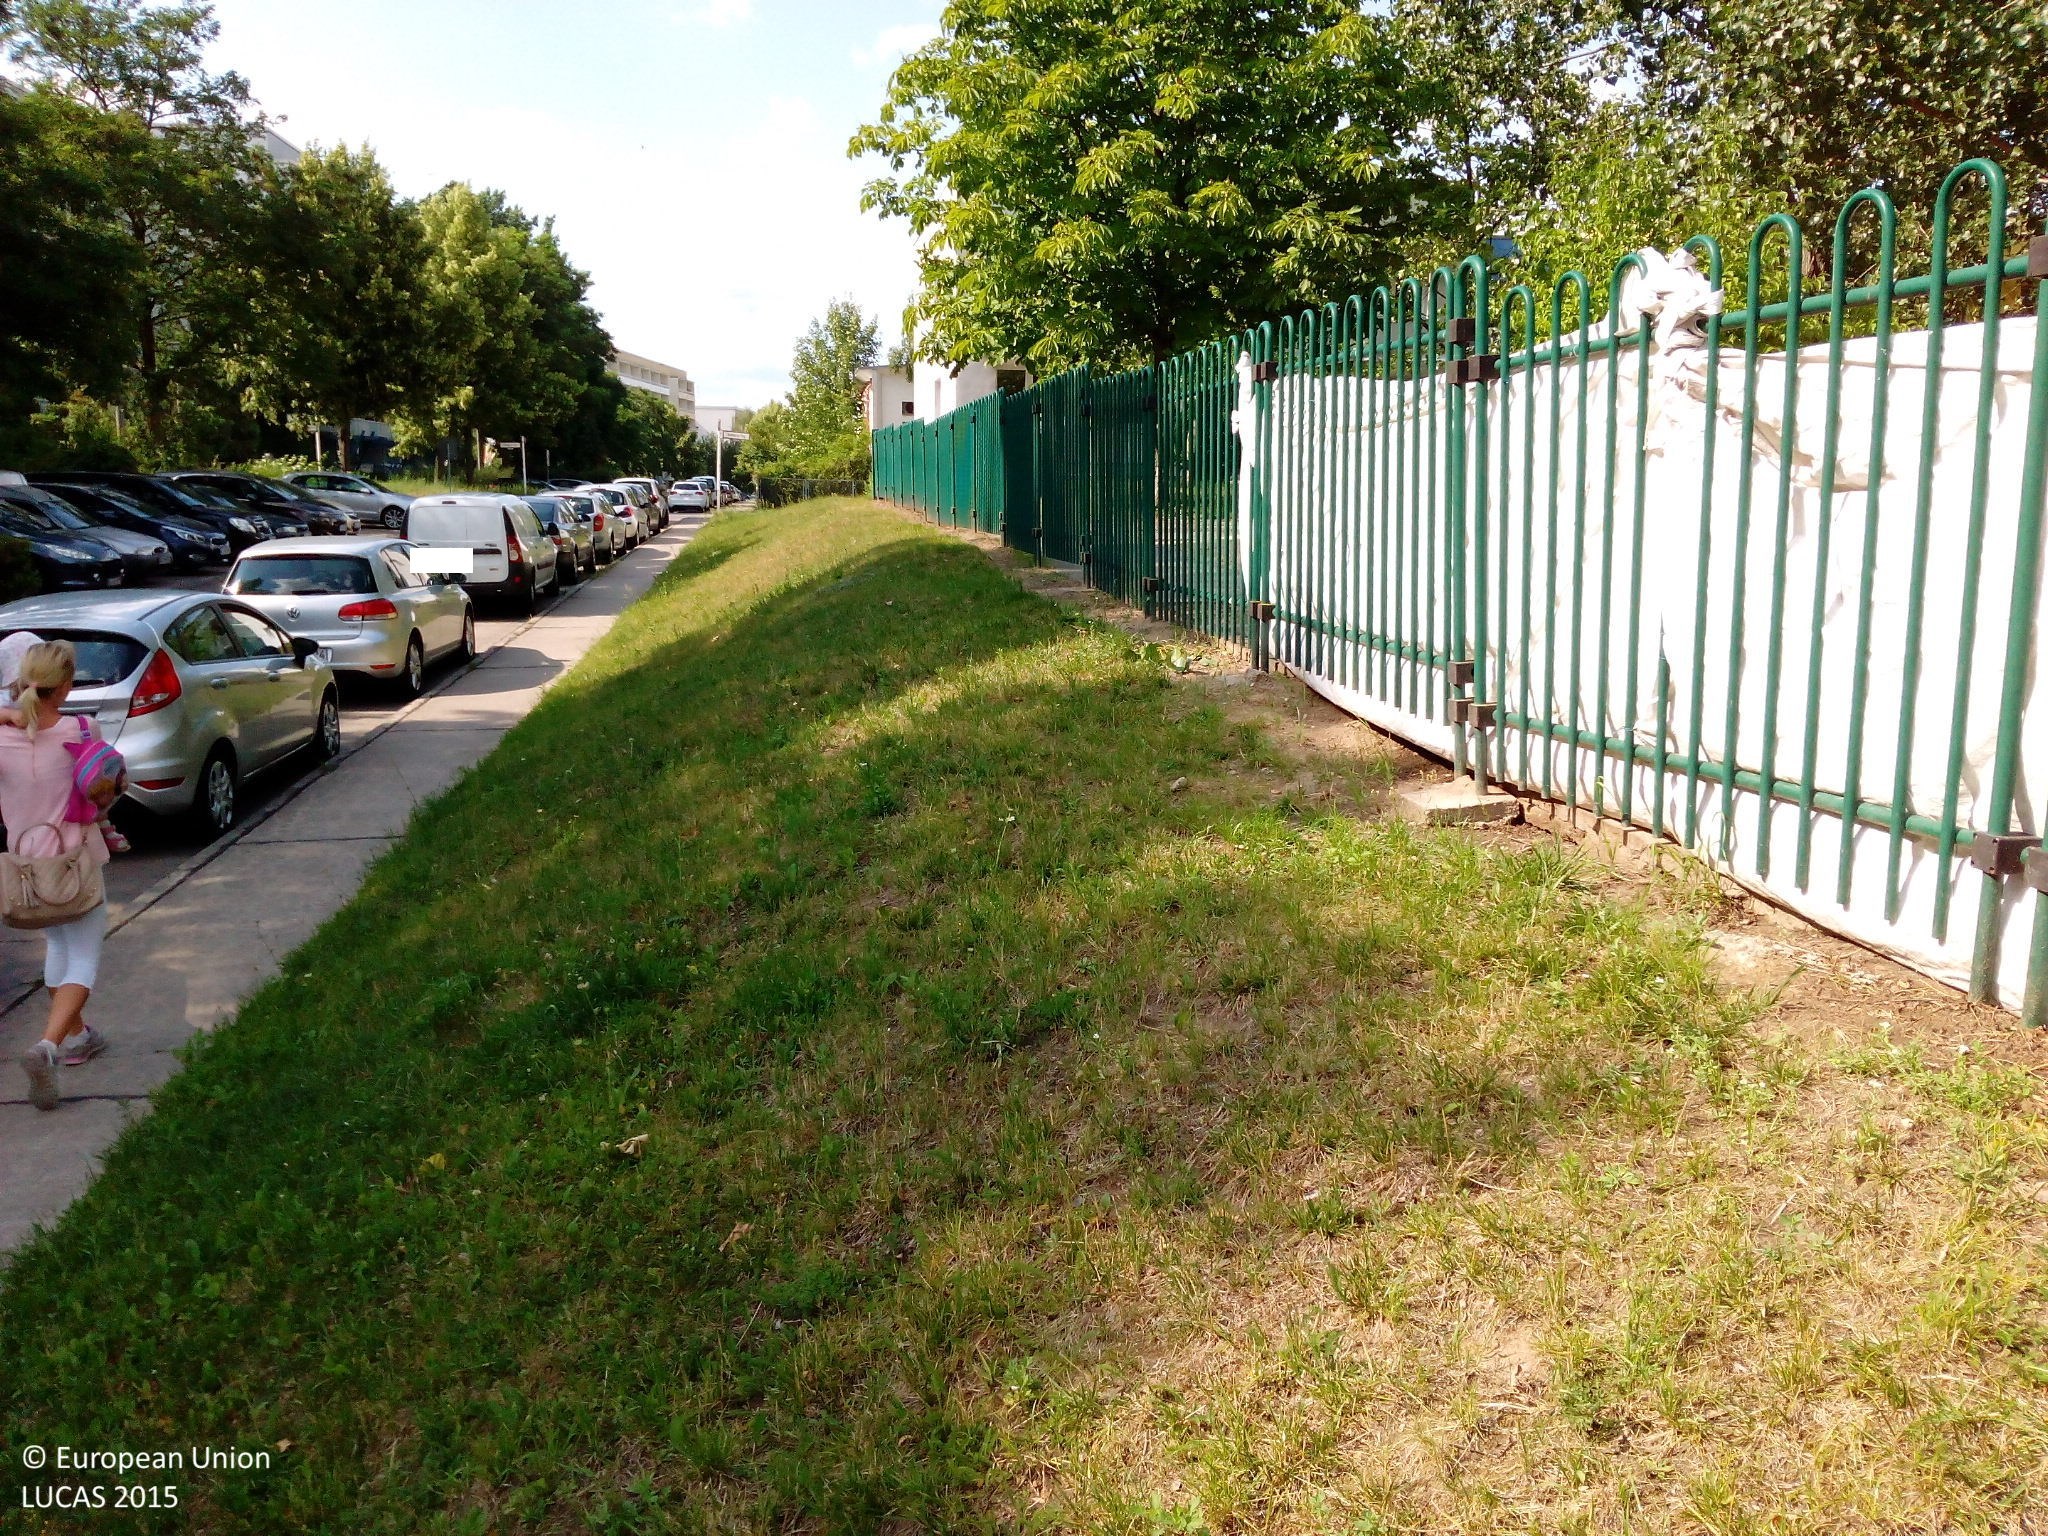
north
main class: Grassland
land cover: Grassland without tree/shrub cover
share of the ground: > 75 %
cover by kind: consolidated bare surface 75 %, herbaceous plants 25 %
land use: Semi-natural and natural areas not in use
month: July
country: DE
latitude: 52.5385
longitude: 13.6125
